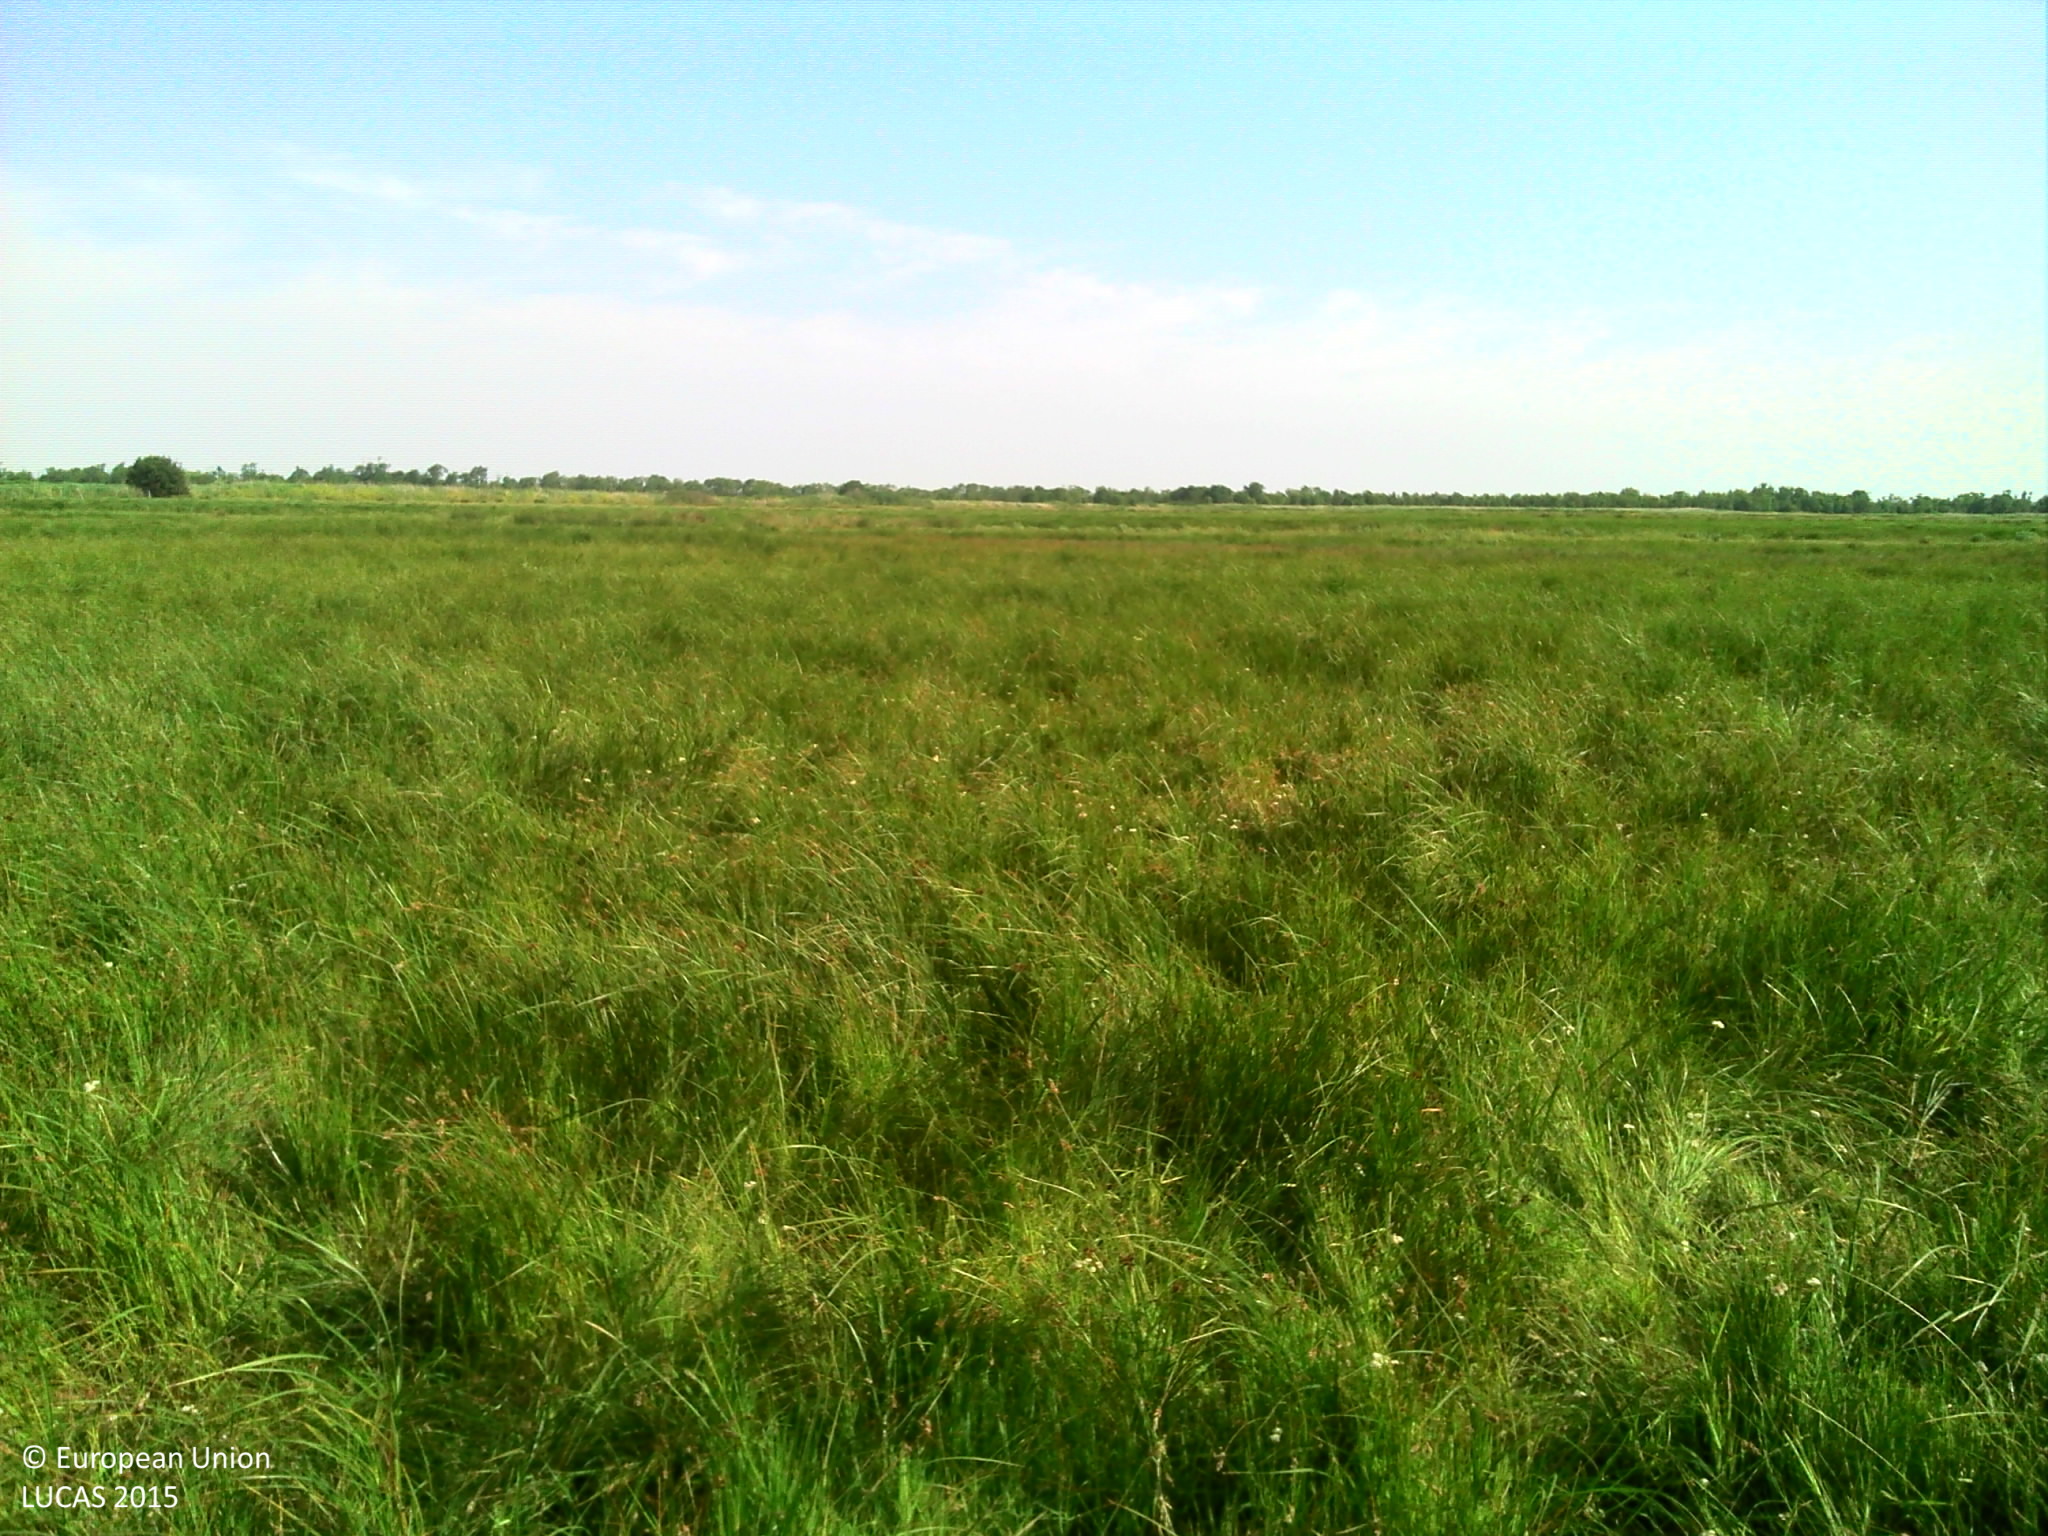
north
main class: Grassland
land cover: Grassland without tree/shrub cover
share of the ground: > 75 %
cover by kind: herbaceous plants 95 %, shrubs 5 %
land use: Agriculture (excluding fallow land and kitchen gardens)
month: June
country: FR
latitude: 46.0161
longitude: -1.0213
